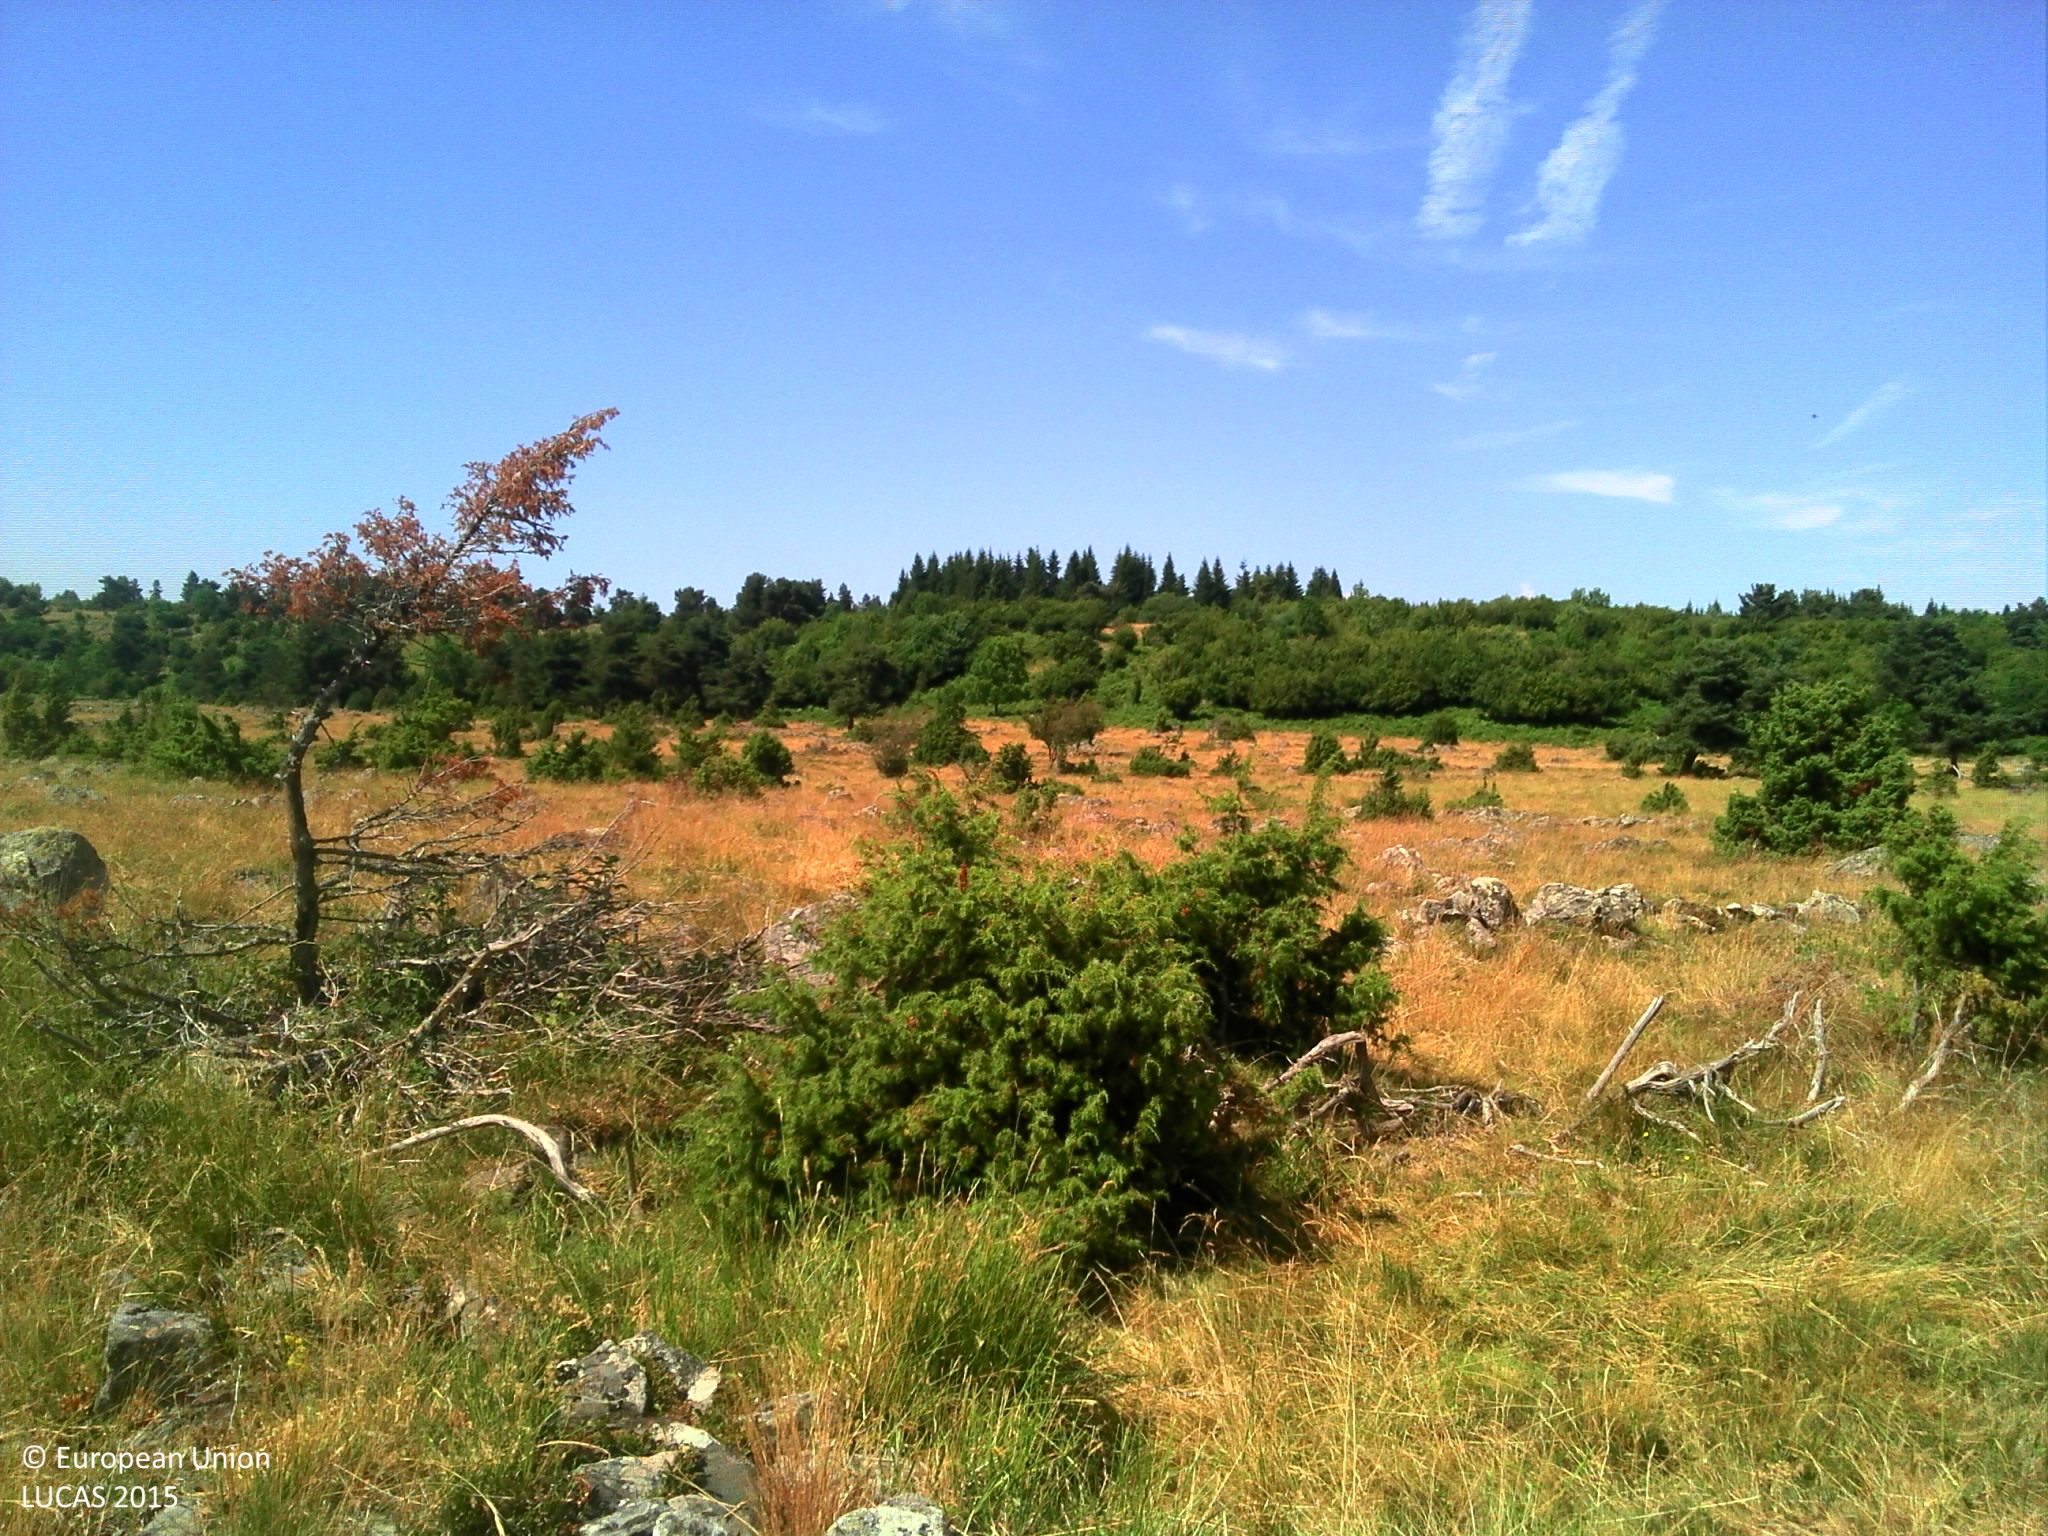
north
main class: Shrubland
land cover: Shrubland with sparse tree cover
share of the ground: > 75 %
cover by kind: herbaceous plants 70 %, shrubs 25 %, coniferous forest trees 5 %
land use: Agriculture (excluding fallow land and kitchen gardens)
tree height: < 5 m
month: July
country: FR
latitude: 45.1364
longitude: 2.8675
